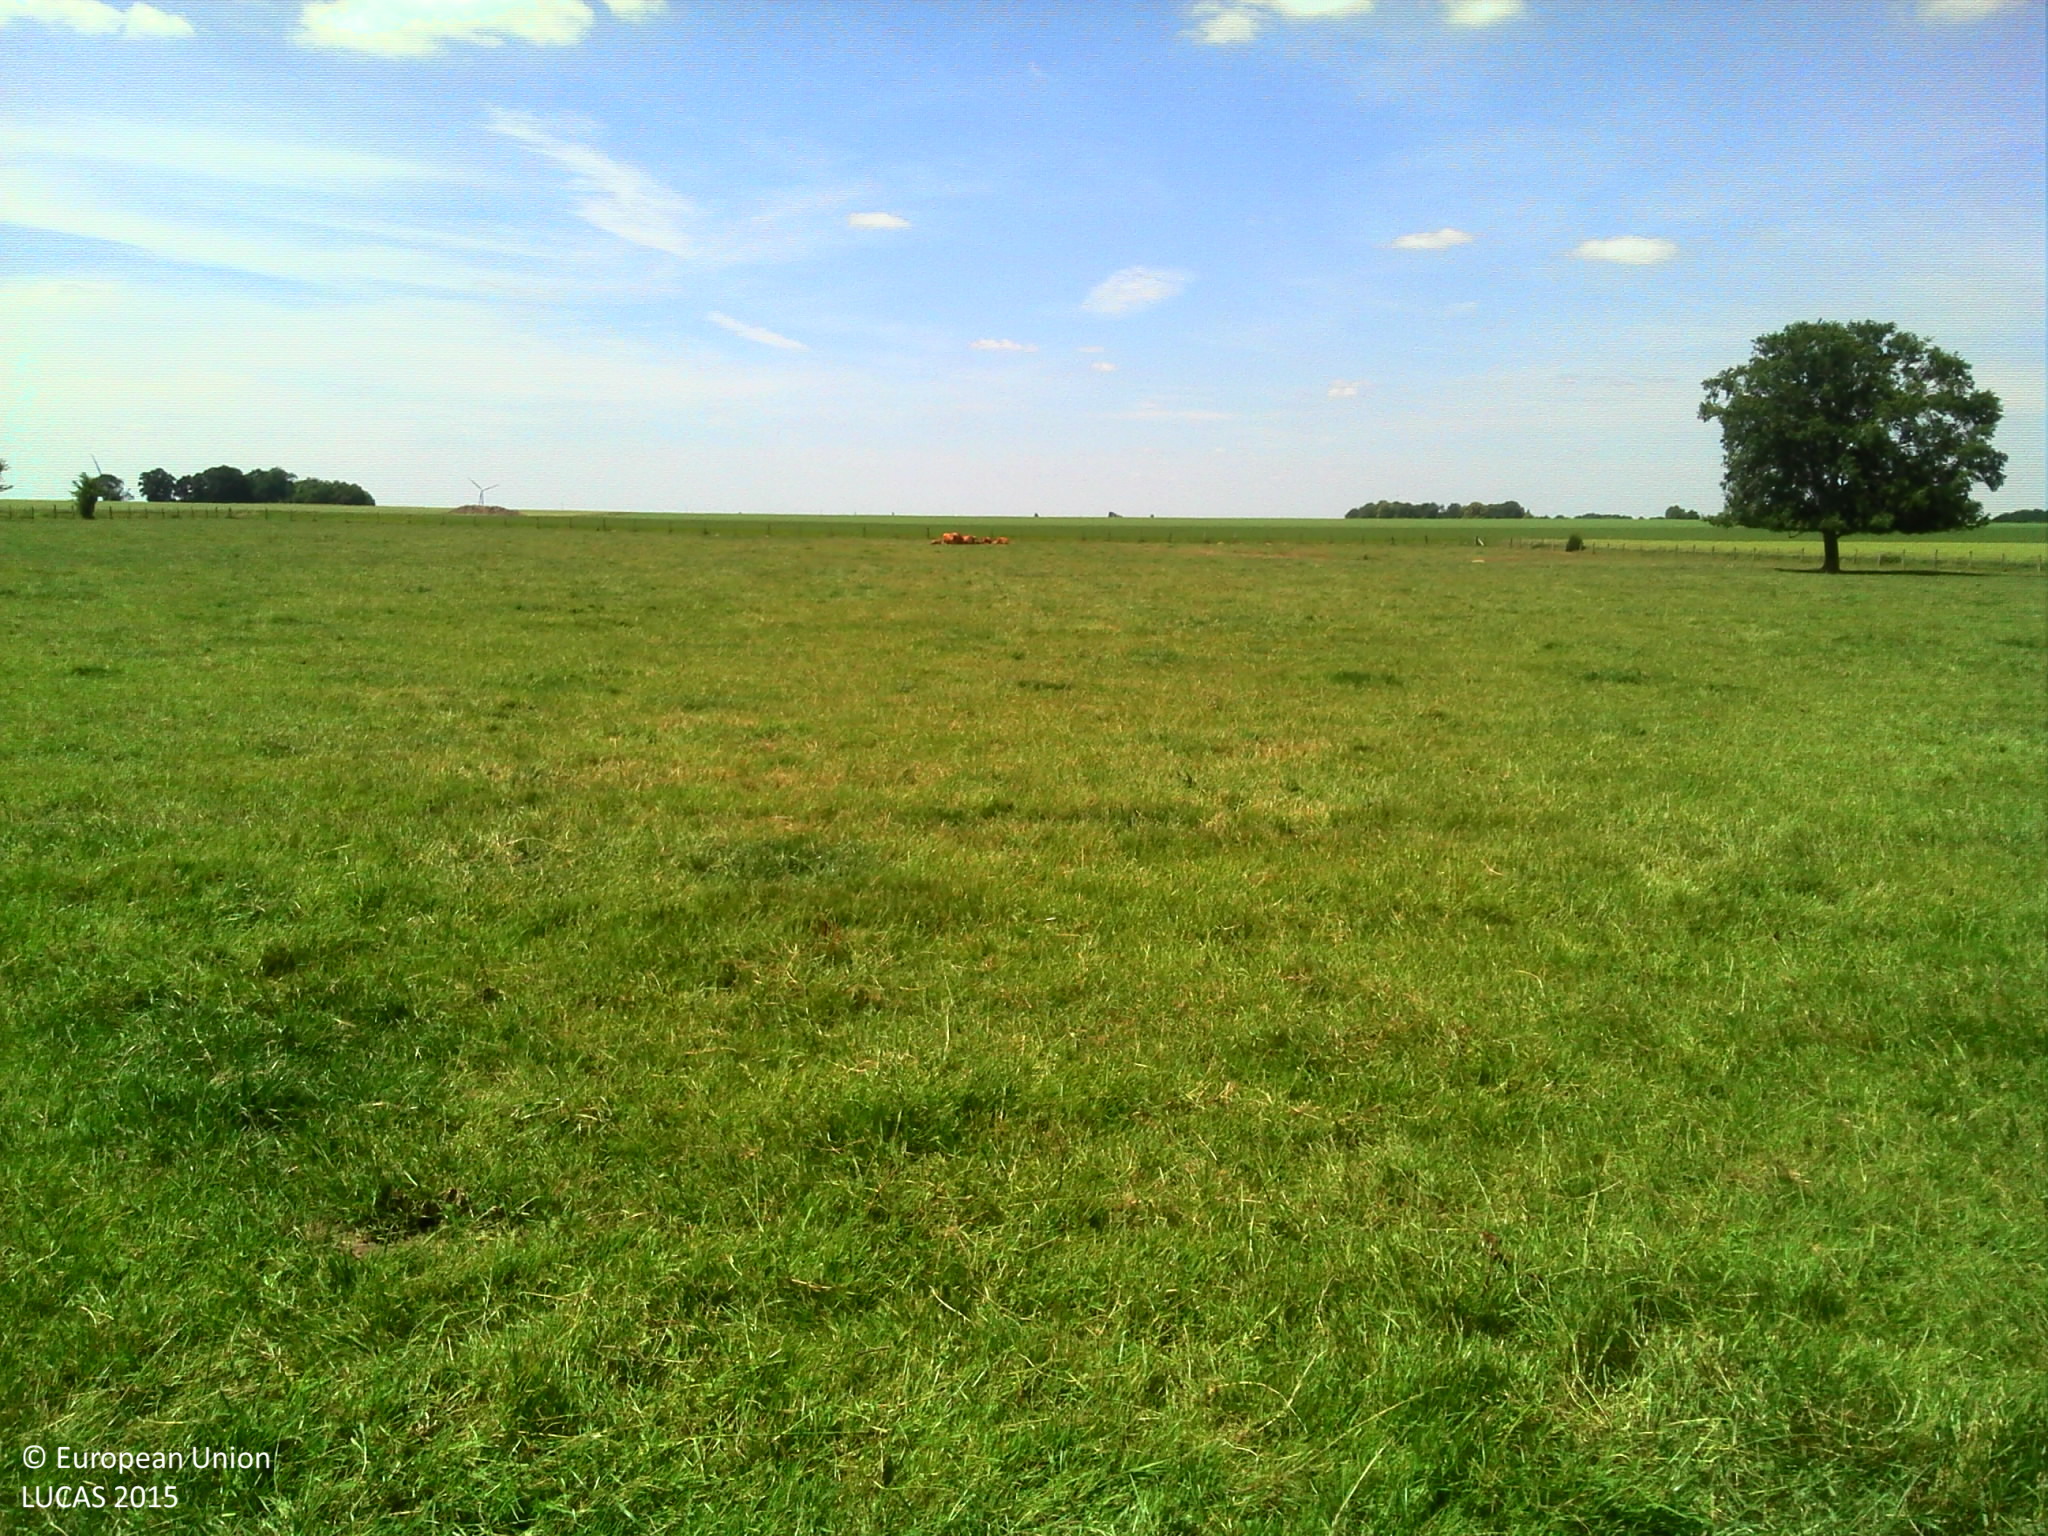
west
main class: Woodland
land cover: Broadleaved woodland
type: mesophytic deciduous forest
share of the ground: > 75 %
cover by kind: broadleaved forest trees 80 %, herbaceous plants 10 %, consolidated bare surface 10 %
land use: Forestry
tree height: > 5 m
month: June
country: FR
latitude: 49.1087
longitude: 1.0608
